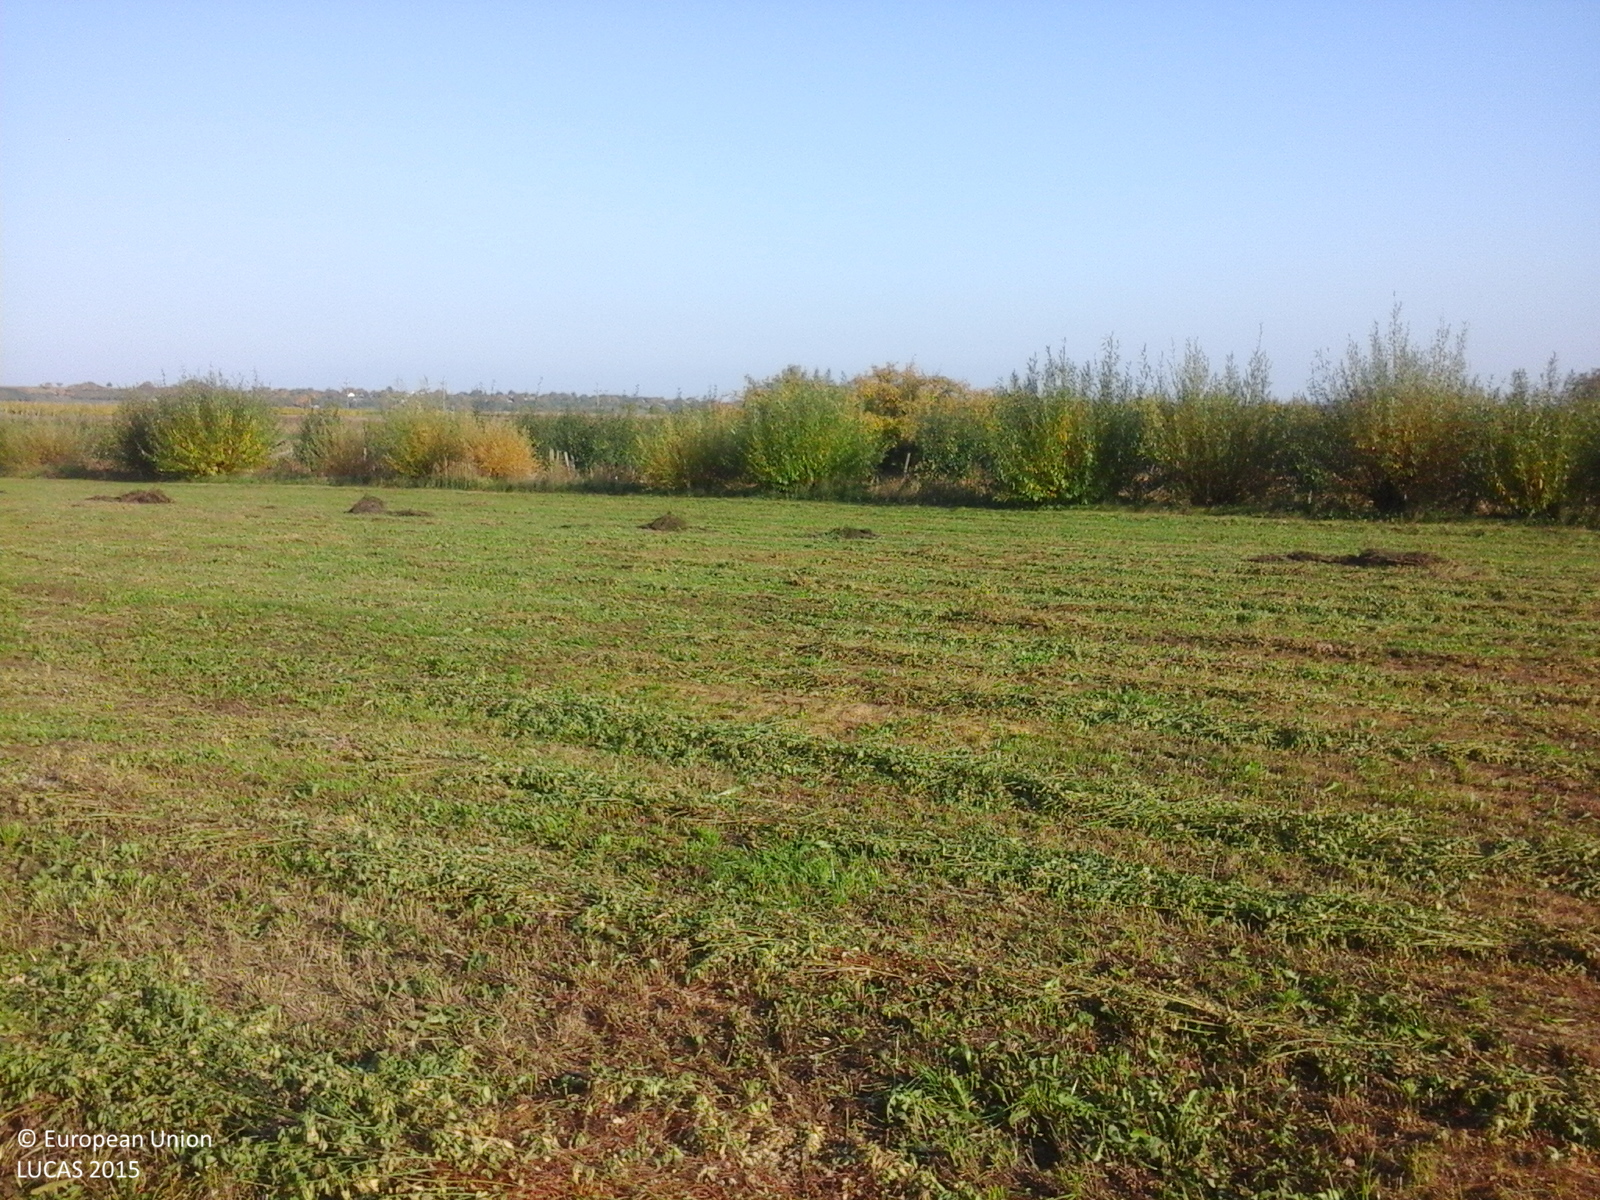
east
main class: Cropland
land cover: Lucerne
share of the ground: > 75 %
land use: Agriculture (excluding fallow land and kitchen gardens)
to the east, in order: Lucerne; Abandoned hedges; Pear fruit; Vineyards; Grassland without tree/shrub cover; Pear fruit; Grassland without tree/shrub cover; Pear fruit; Maize; Lucerne; Maize
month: October
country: RO
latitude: 45.9607
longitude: 27.0613
